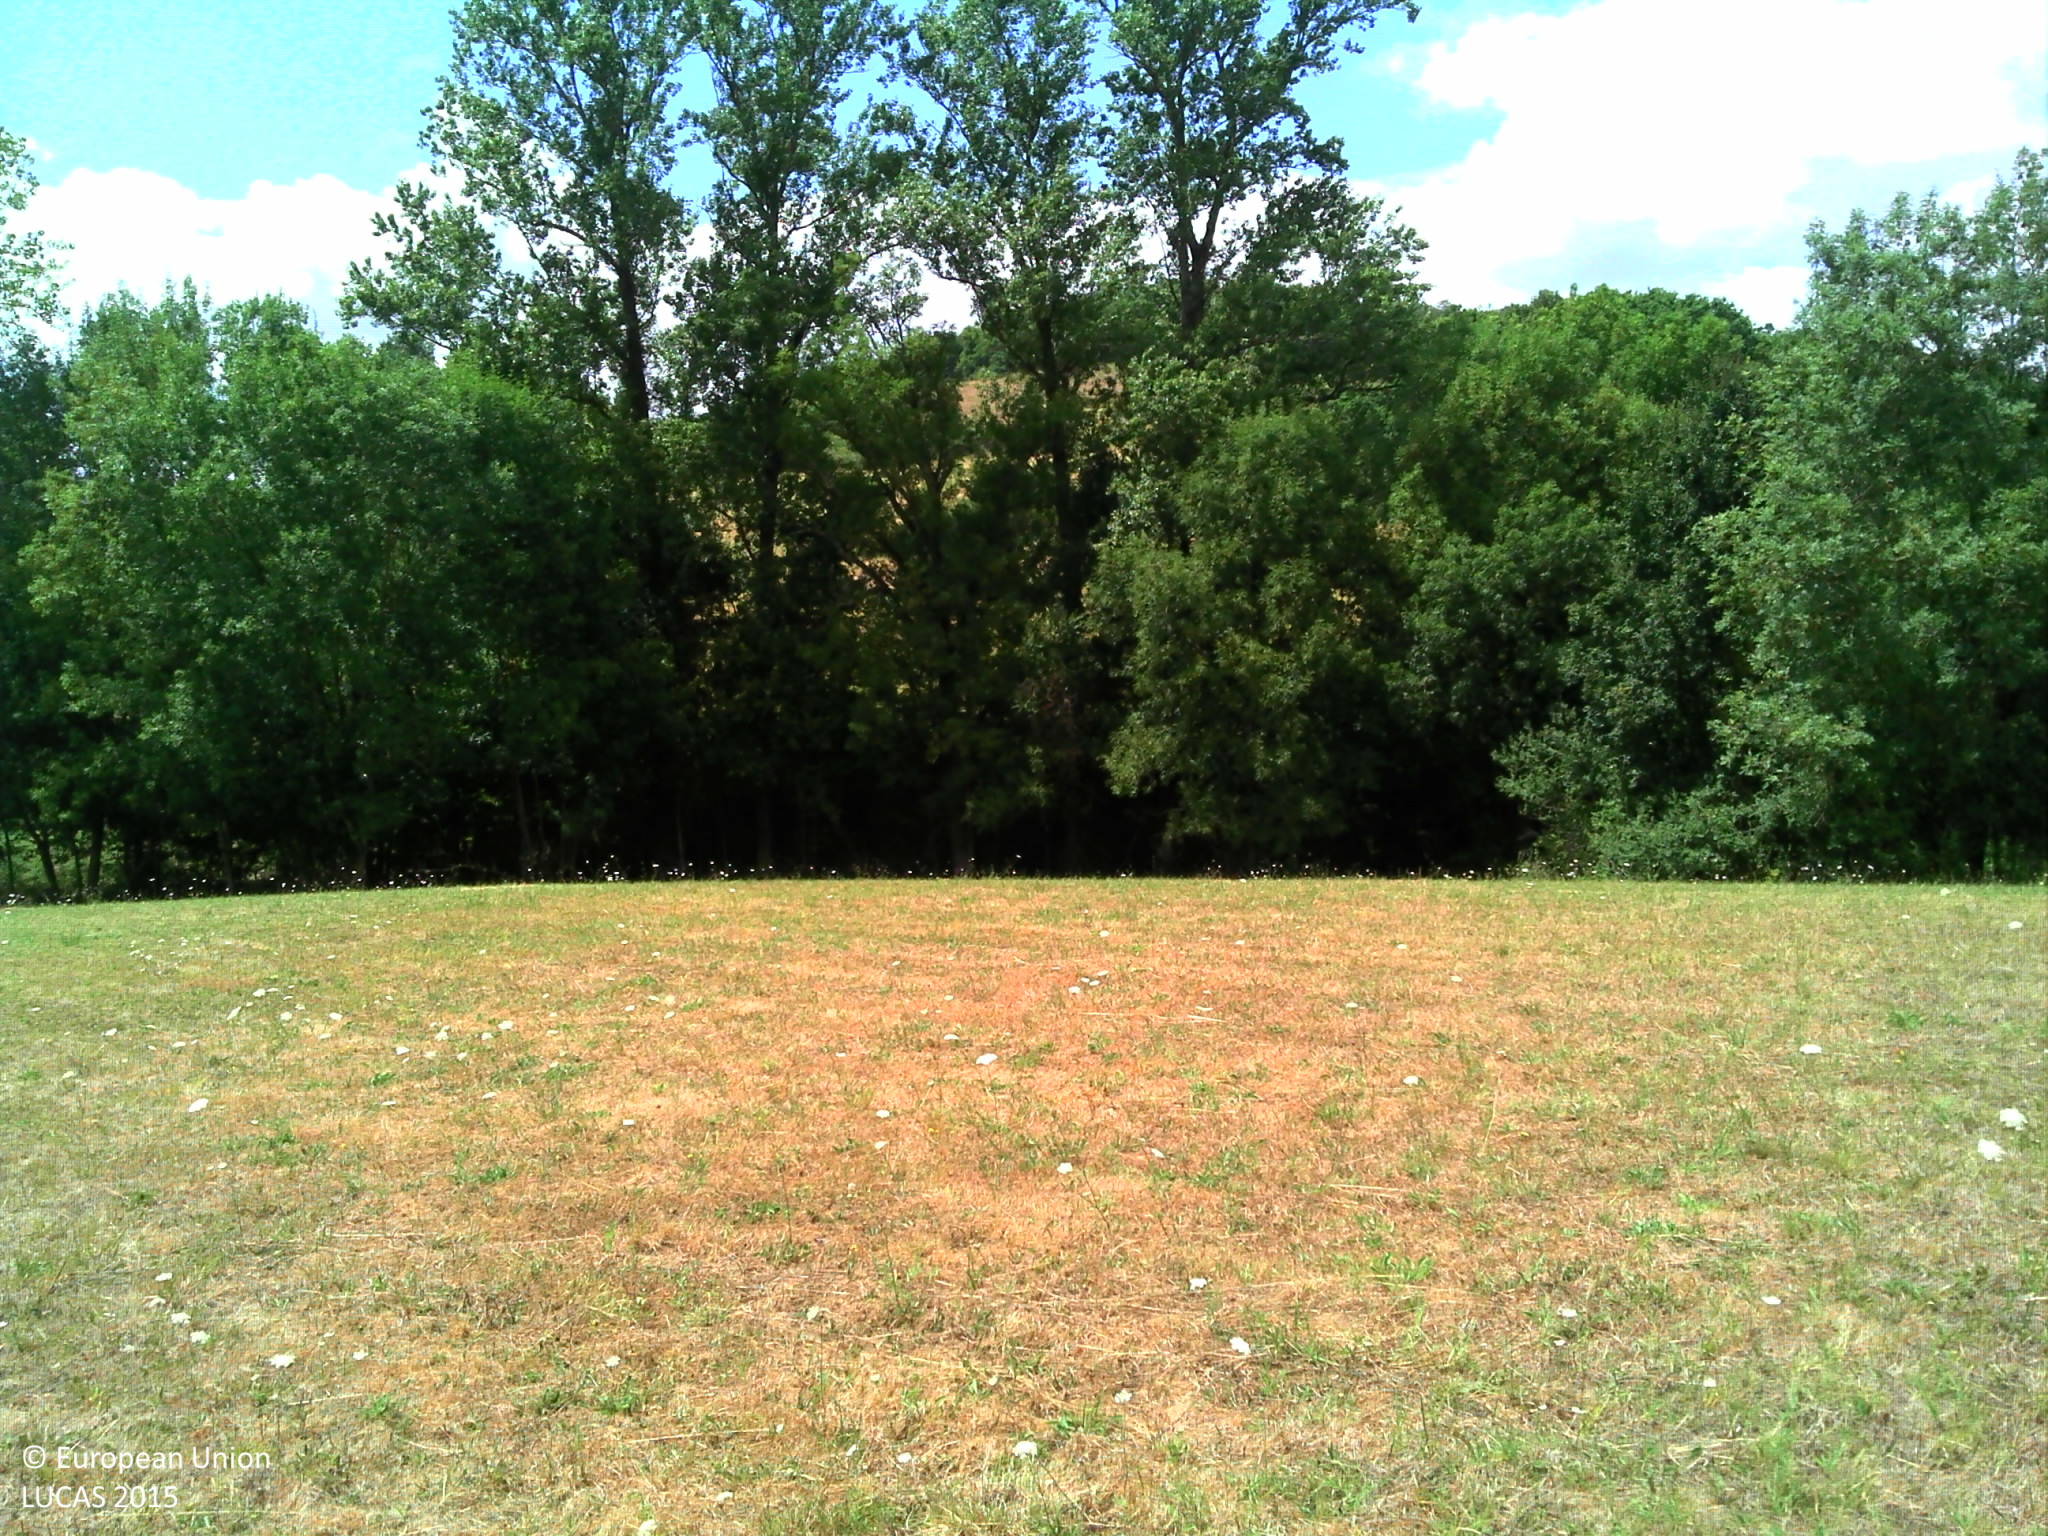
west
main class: Grassland
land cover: Grassland without tree/shrub cover
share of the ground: > 75 %
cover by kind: herbaceous plants 100 %
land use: Agriculture (excluding fallow land and kitchen gardens)
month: July
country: FR
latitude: 44.4833
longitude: 0.5753
